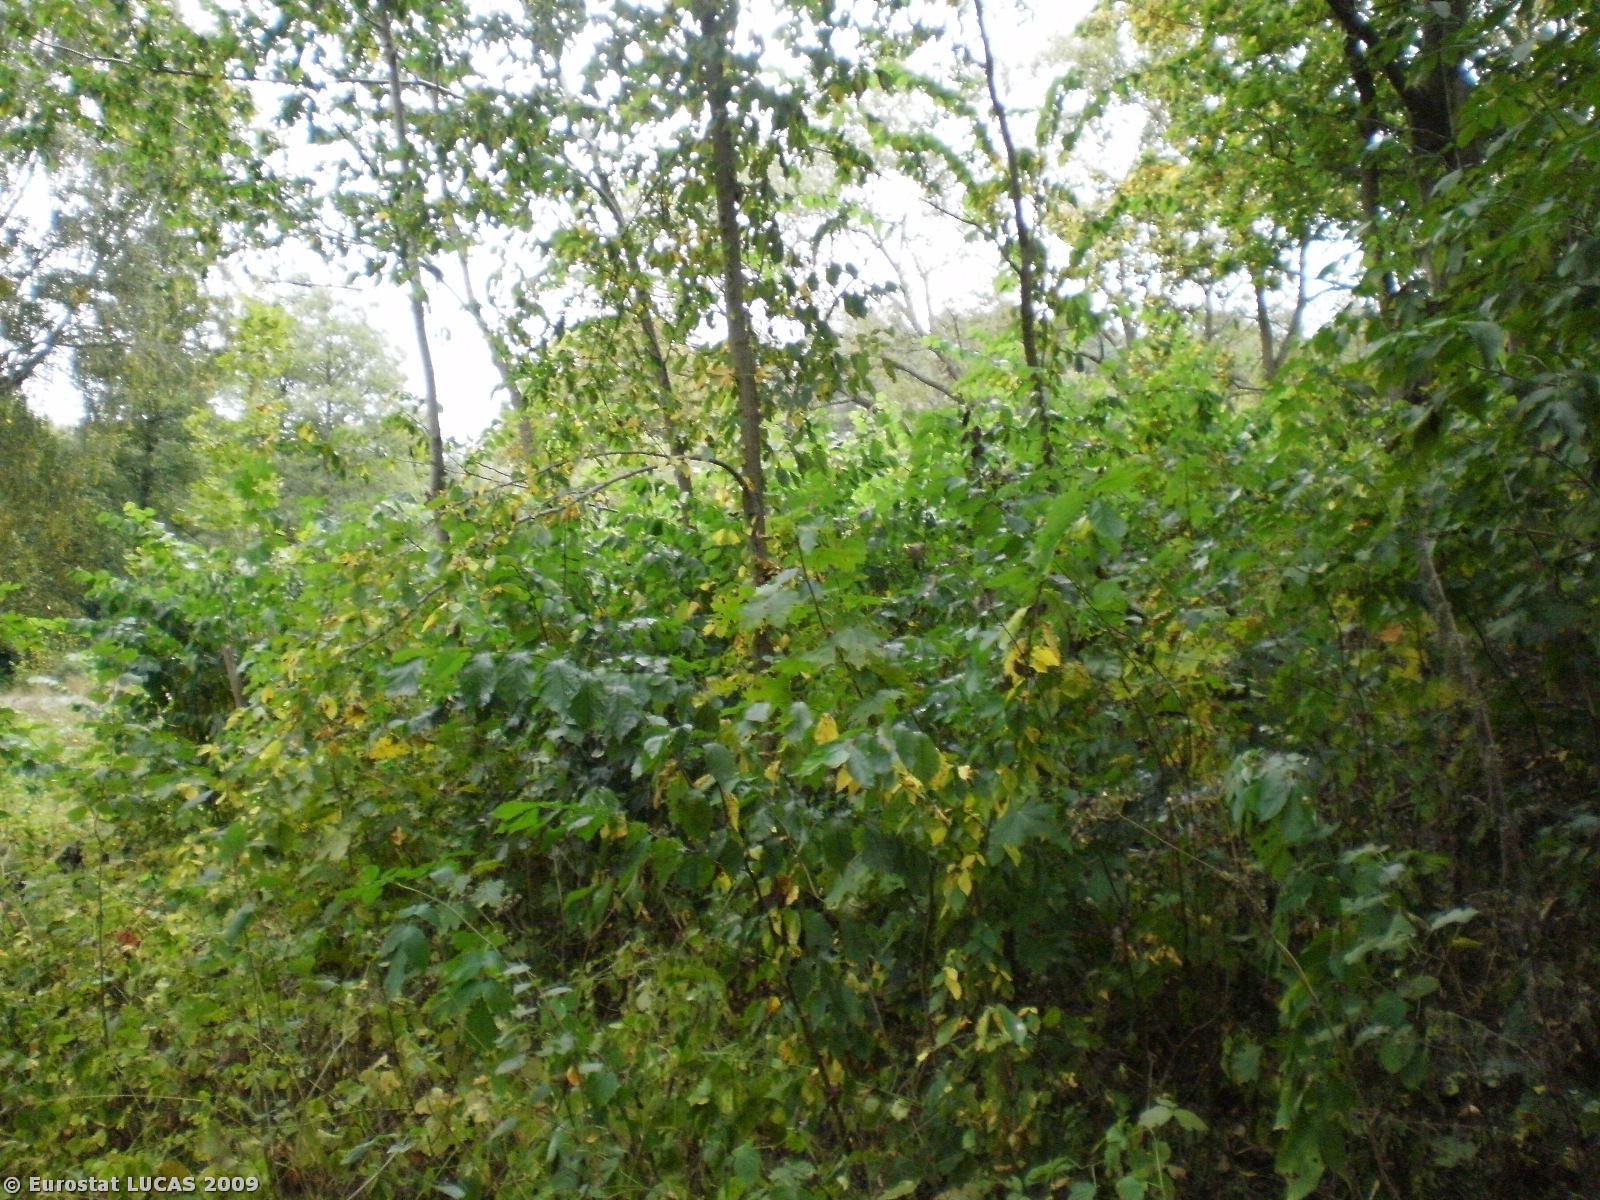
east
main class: Woodland
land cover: Broadleaved woodland
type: mesophytic deciduous forest
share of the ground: > 75 %
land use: Forestry
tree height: > 5 m
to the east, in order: Broadleaved woodland
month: August
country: PL
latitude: 53.5339
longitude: 21.9609
